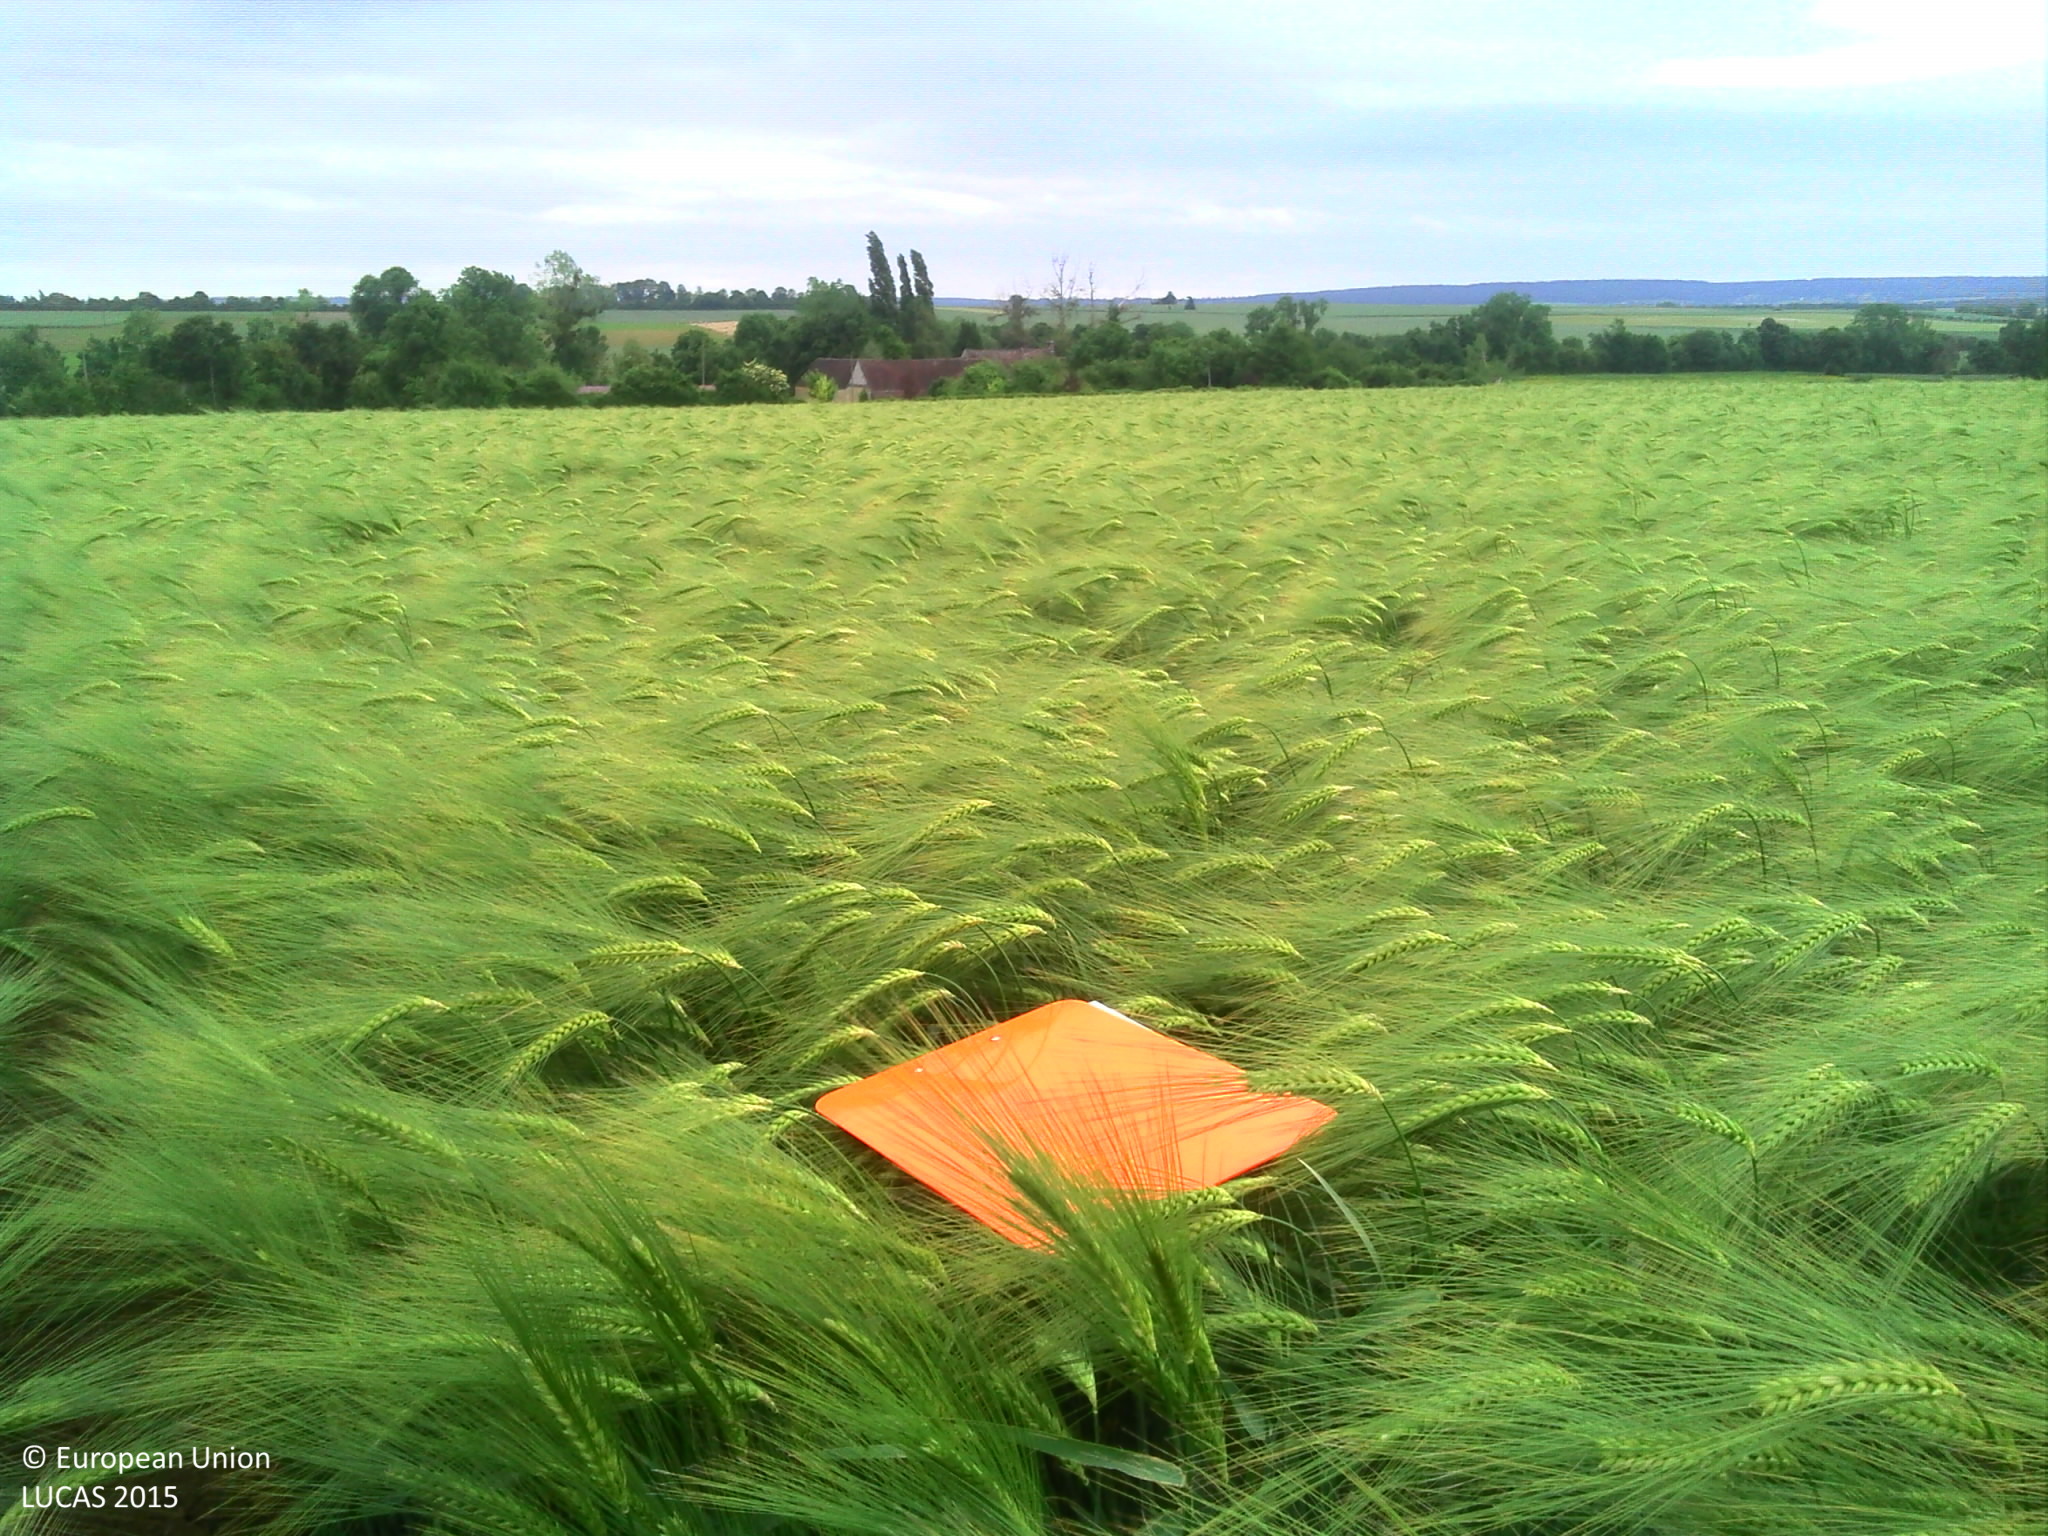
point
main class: Cropland
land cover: Barley
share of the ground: > 75 %
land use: Agriculture (excluding fallow land and kitchen gardens)
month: June
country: FR
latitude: 48.8431
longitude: 0.0641
